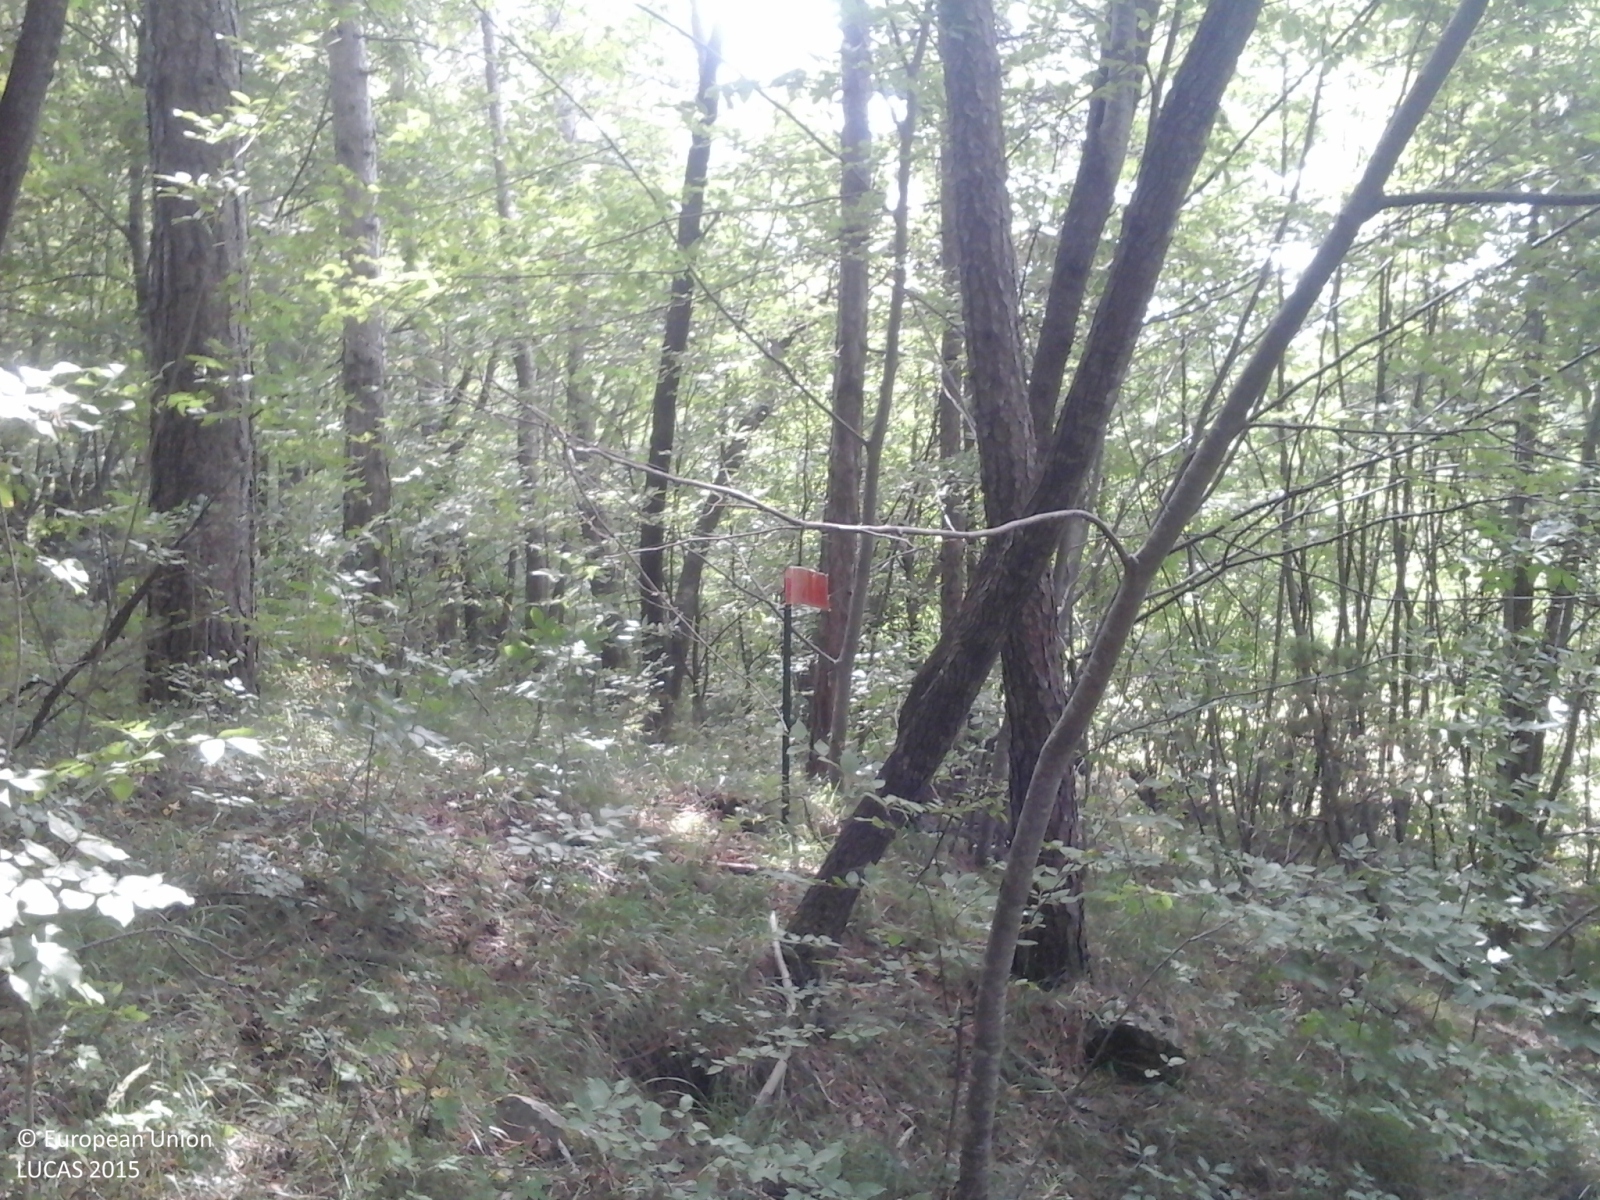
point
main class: Woodland
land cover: Pine dominated mixed woodland
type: coniferous forest of the mediterranean region
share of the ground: > 75 %
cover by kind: coniferous forest trees 75 %, broadleaved forest trees 25 %
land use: Forestry
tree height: > 5 m
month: July
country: IT
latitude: 44.4044
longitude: 10.2380
